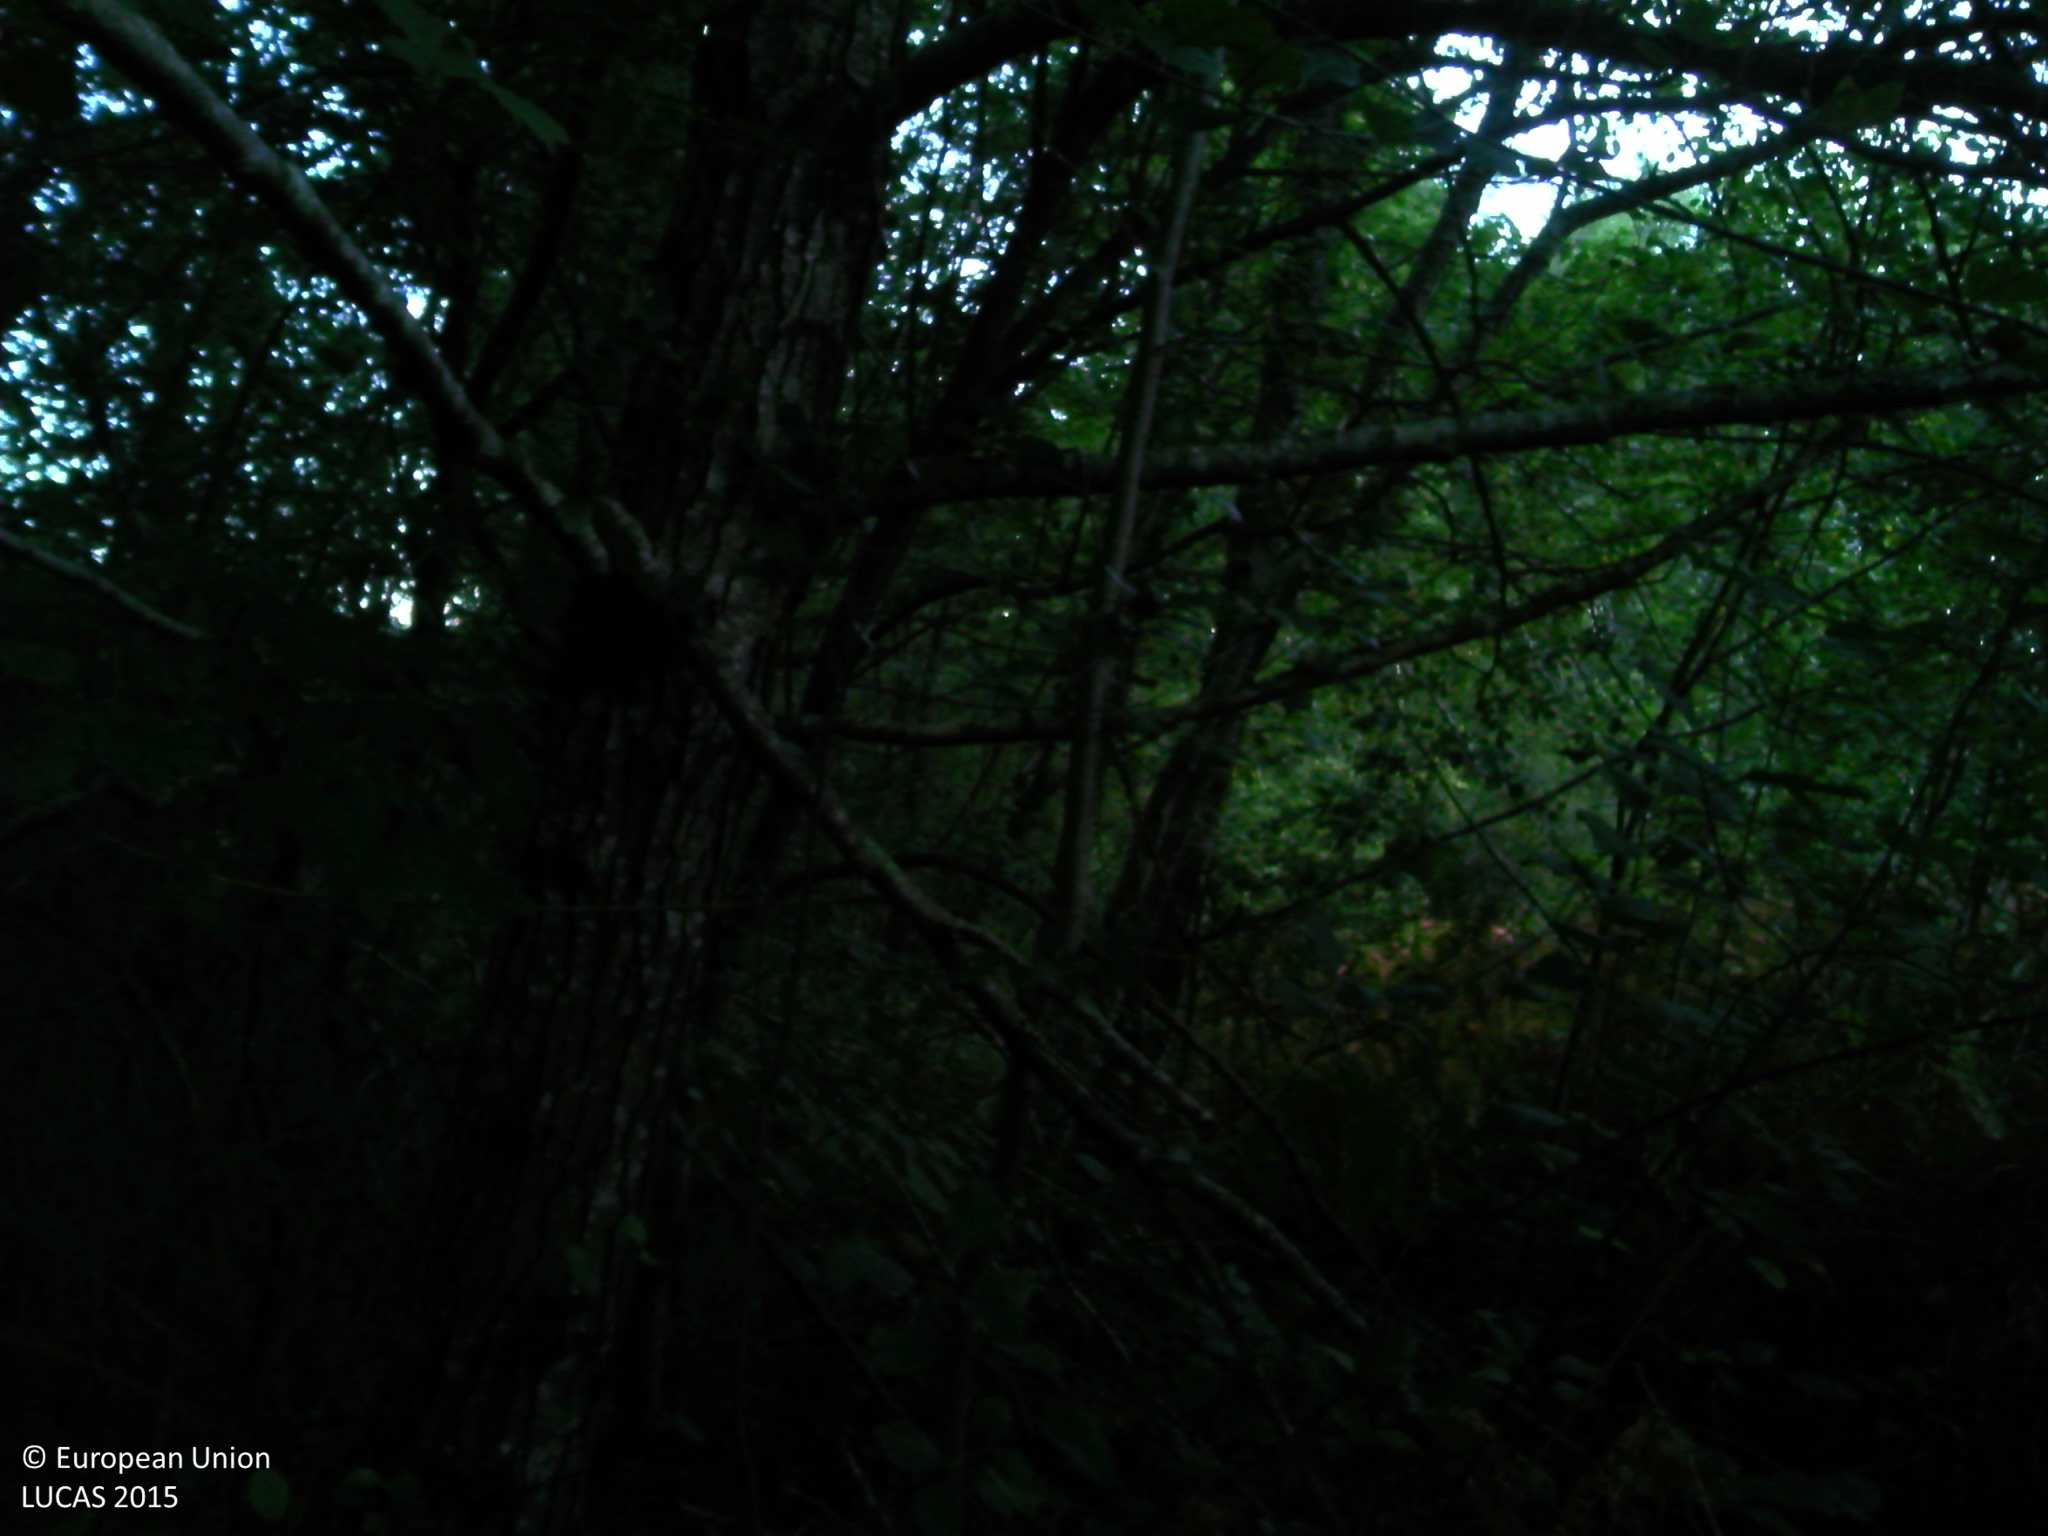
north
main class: Woodland
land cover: Broadleaved woodland
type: acidophilous oak and oak-birch forest
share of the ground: > 75 %
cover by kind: broadleaved forest trees 75 %, shrubs 10 %, herbaceous plants 10 %, lichens and mosses 5 %
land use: Forestry
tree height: > 5 m
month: September
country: FR
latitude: 43.1571
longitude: -0.7203
